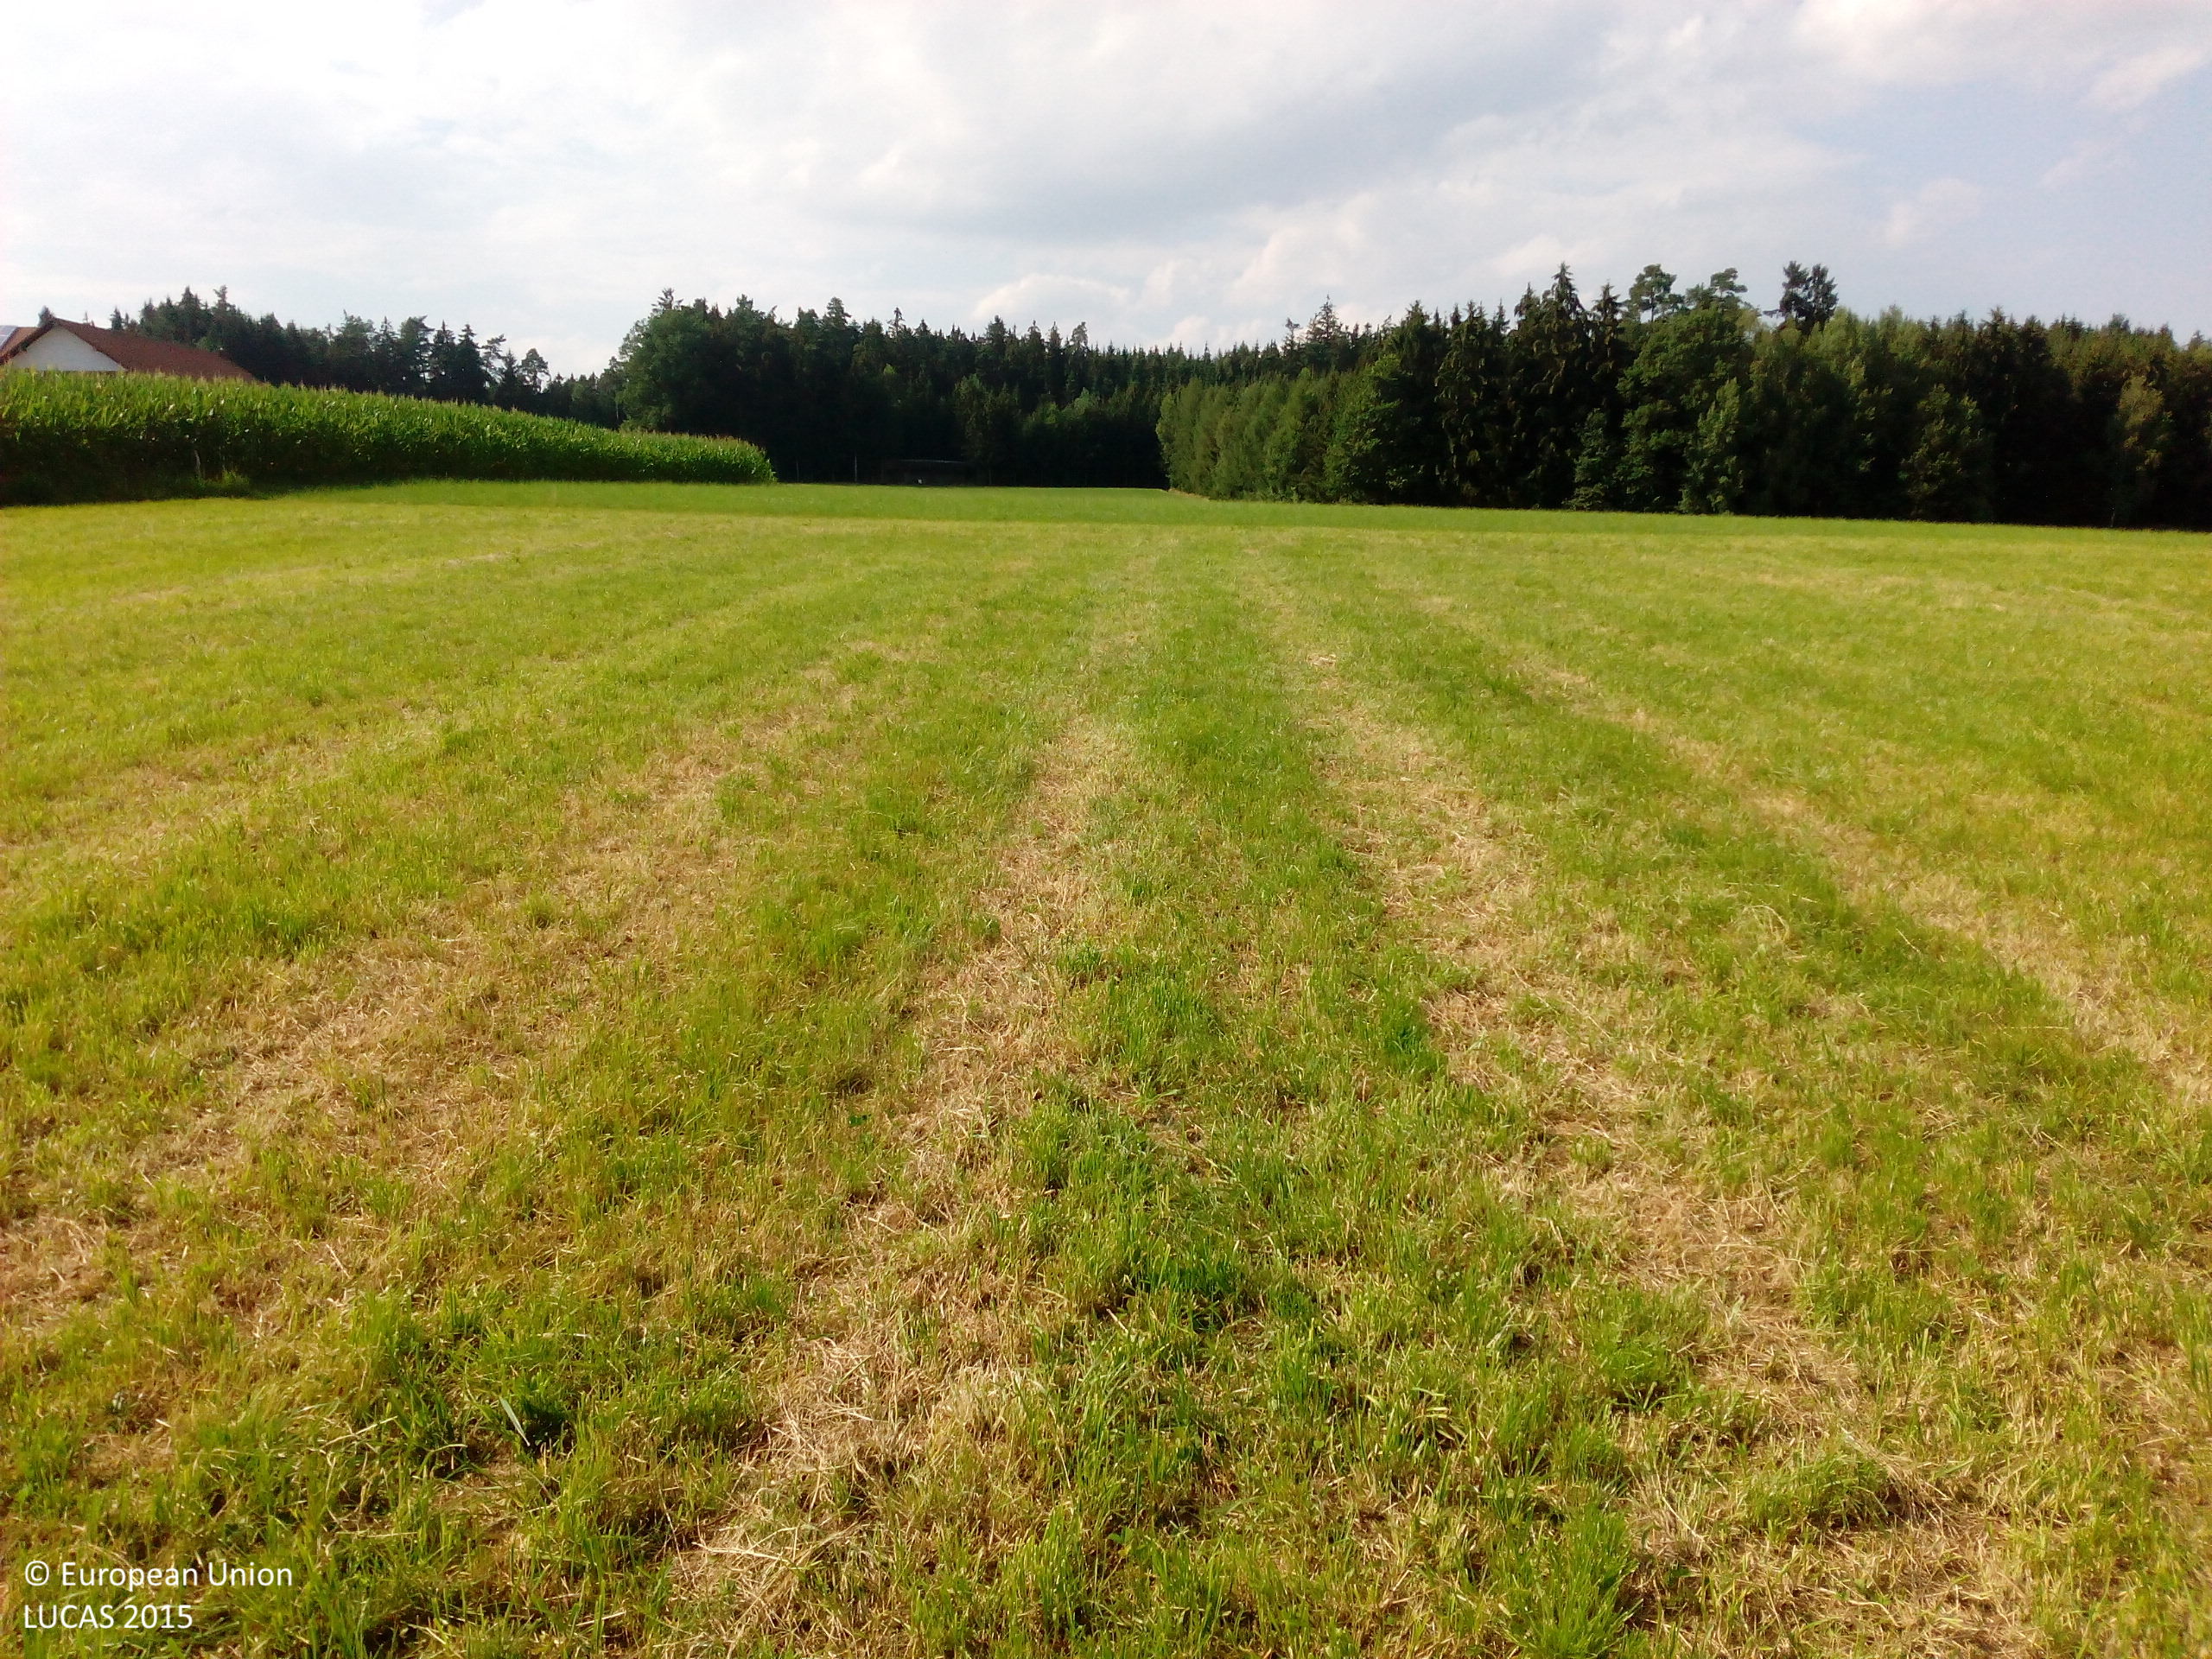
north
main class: Grassland
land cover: Grassland without tree/shrub cover
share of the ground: > 75 %
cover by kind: herbaceous plants 100 %
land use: Agriculture (excluding fallow land and kitchen gardens)
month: July
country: DE
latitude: 48.3834
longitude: 12.9022
